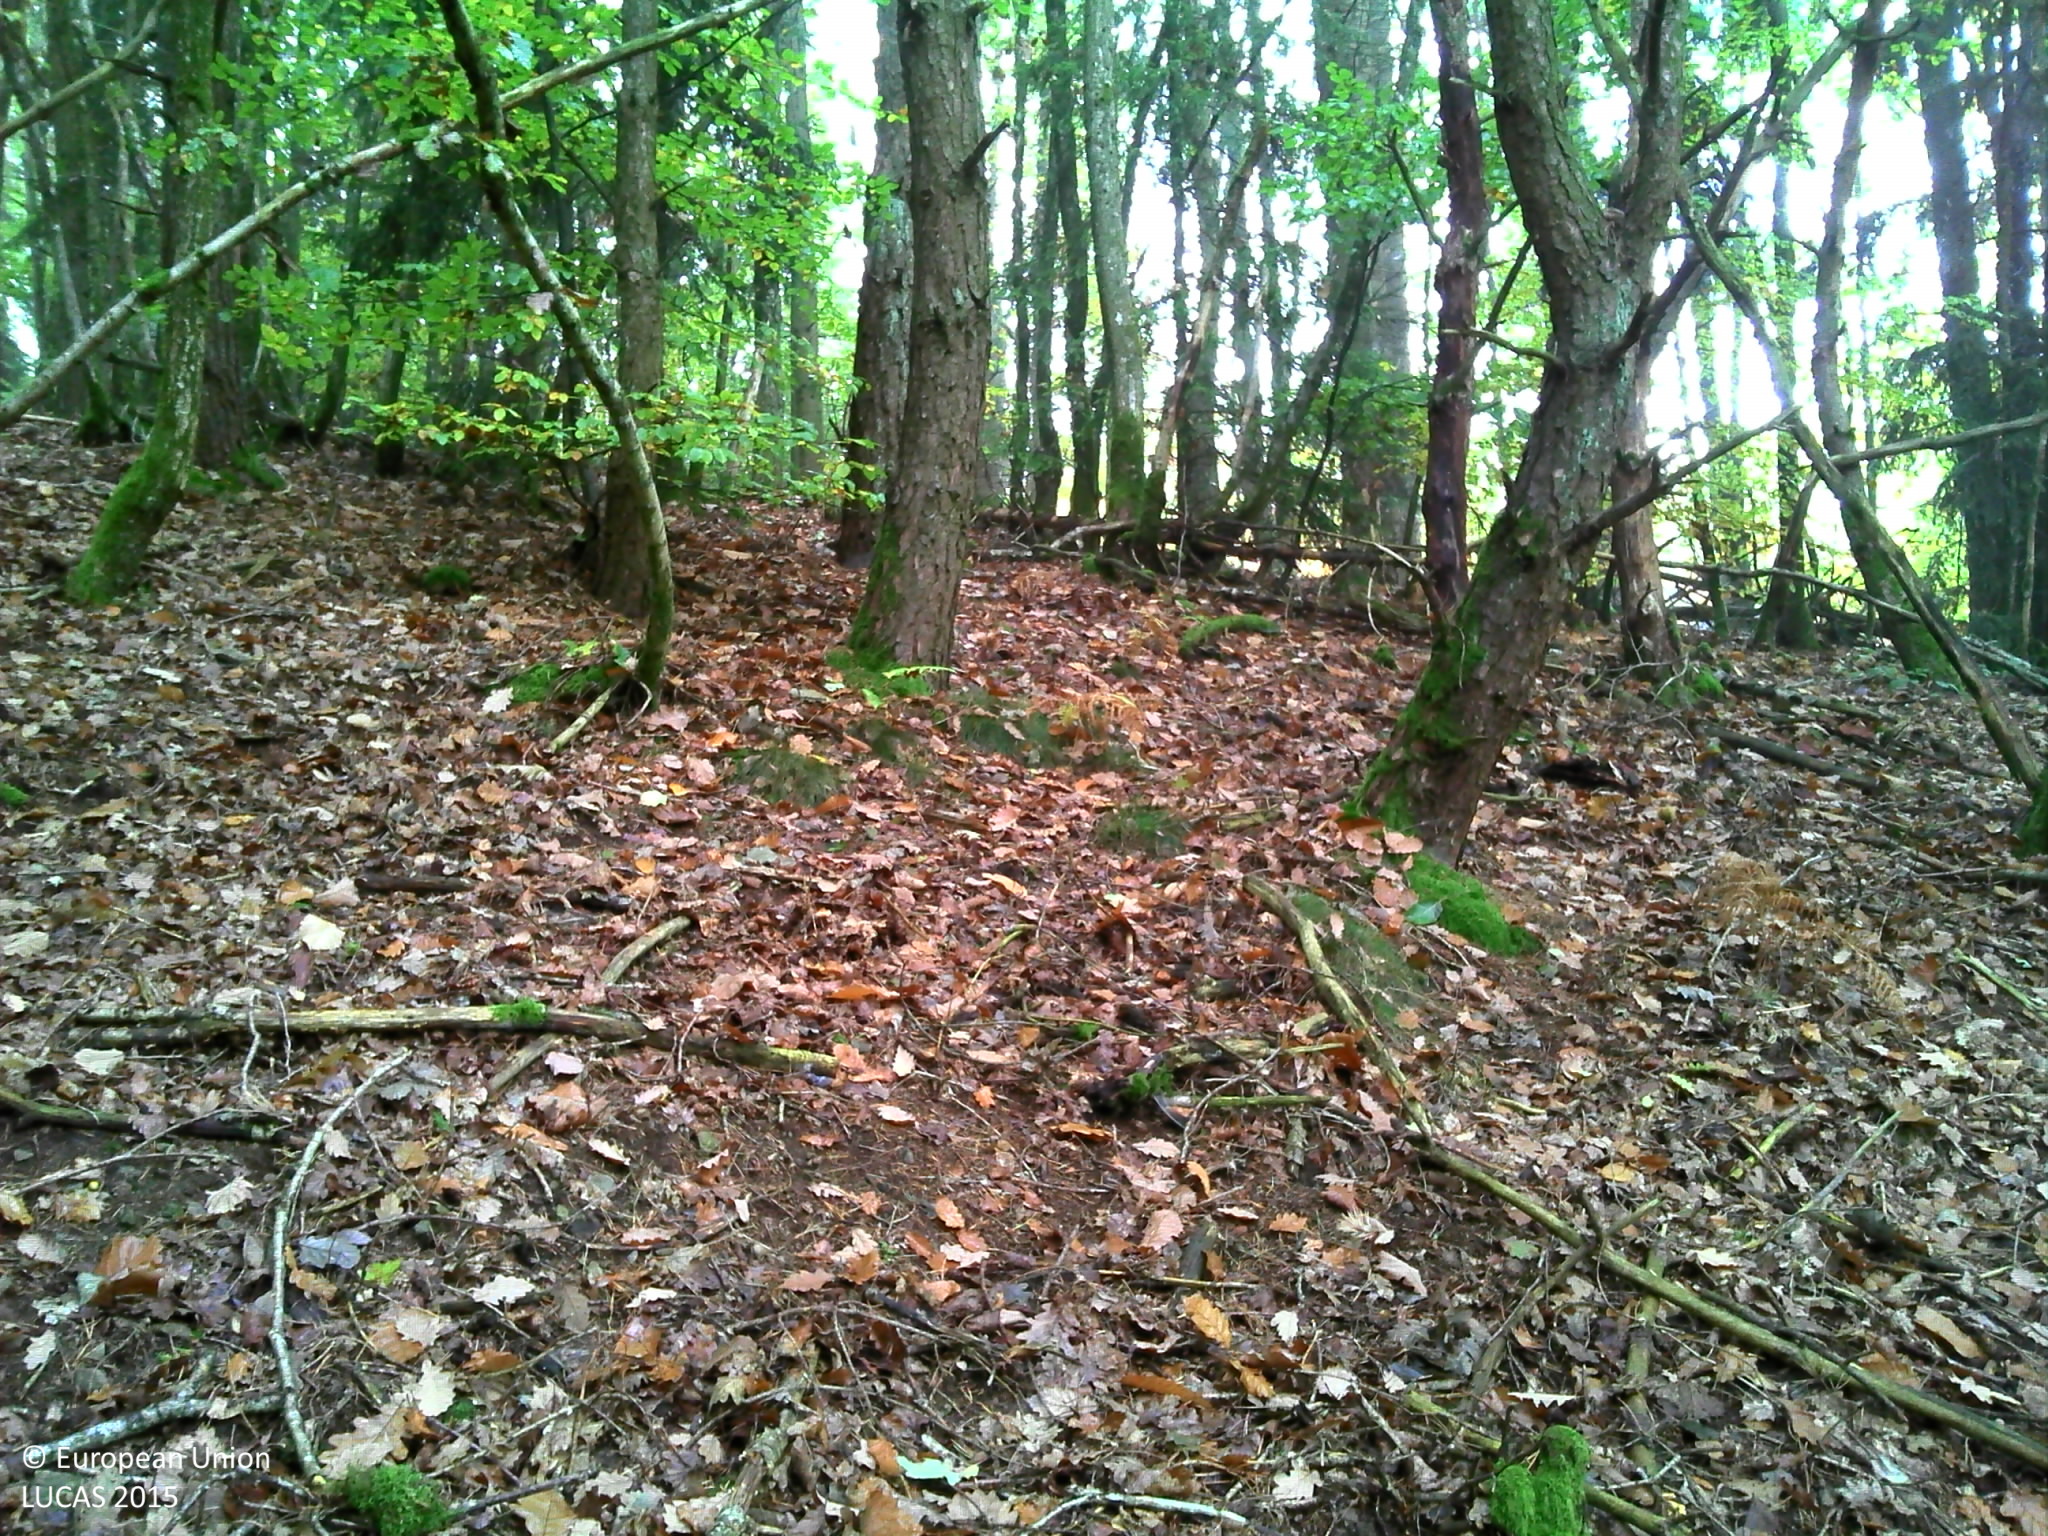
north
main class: Woodland
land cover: Spruce dominated mixed woodland
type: hemiboreal forest and nemoral coniferous forest and mixed broadleaved-coniferous forest
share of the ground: > 75 %
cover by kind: coniferous forest trees 60 %, broadleaved forest trees 25 %, herbaceous plants 15 %
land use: Forestry
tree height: > 5 m
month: October
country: FR
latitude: 46.1437
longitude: 2.7865
